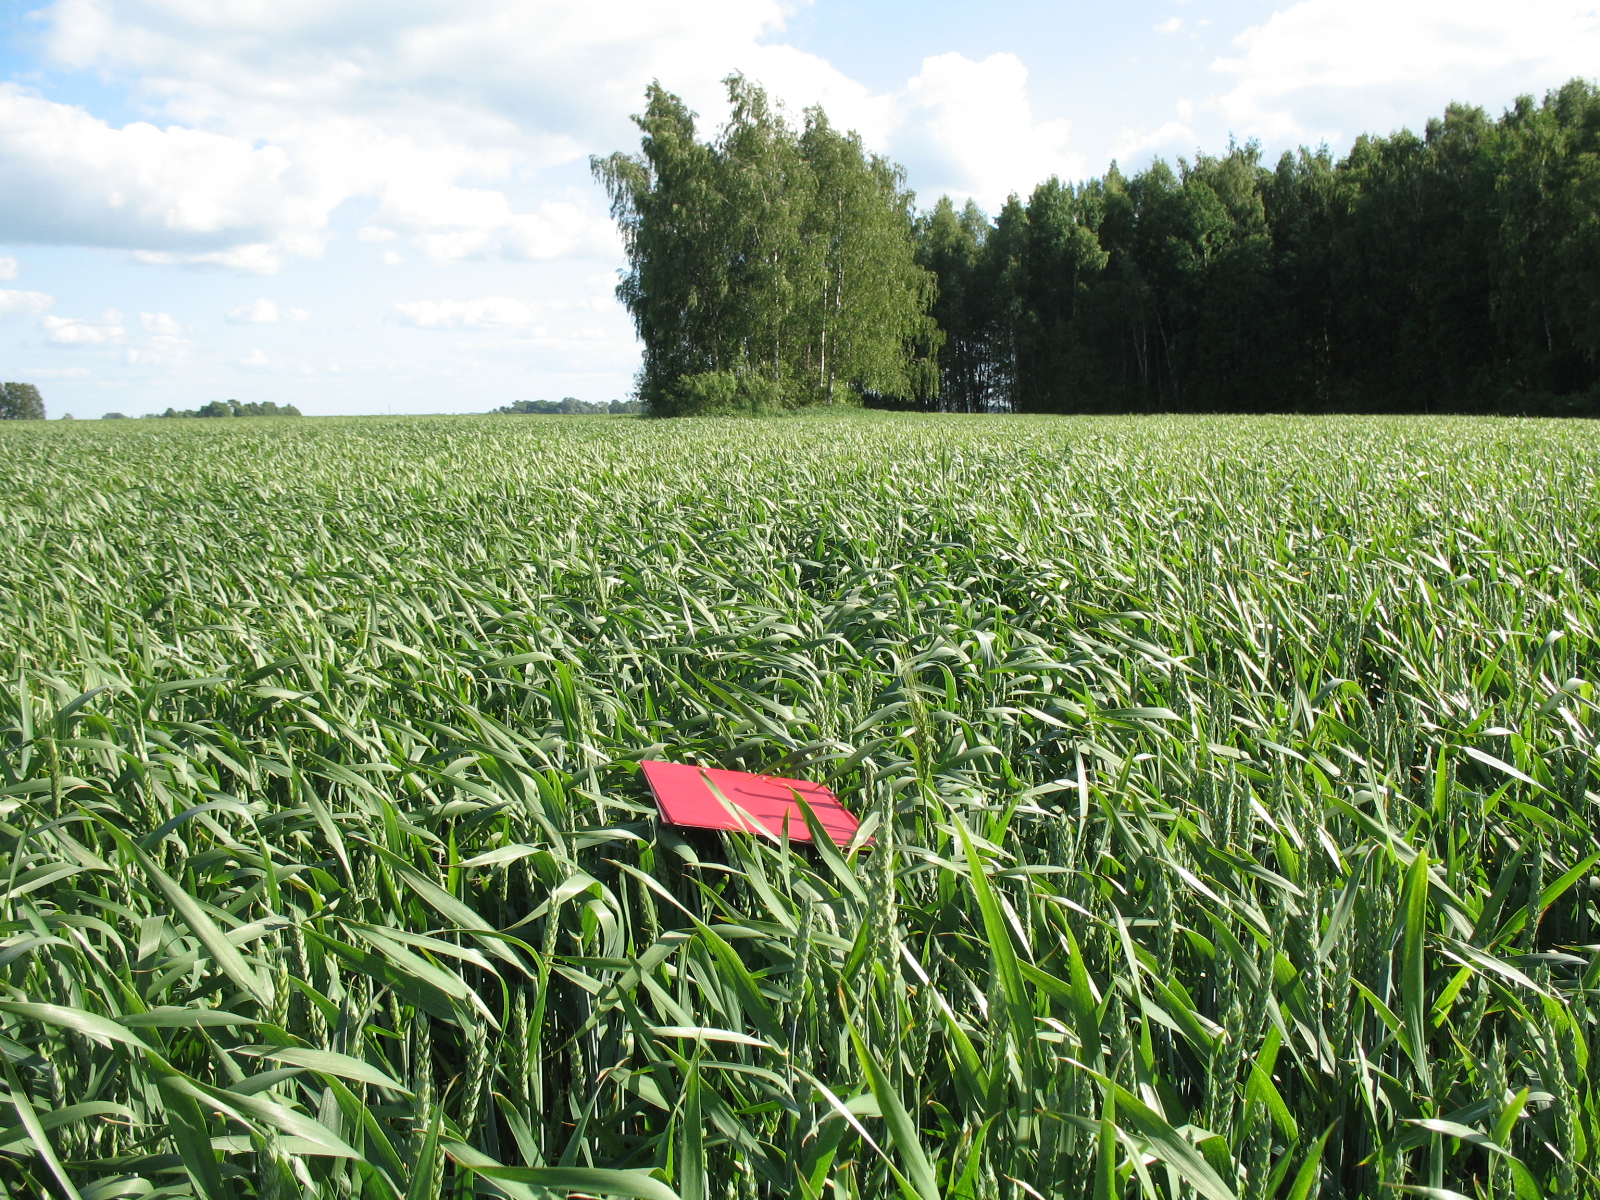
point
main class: Cropland
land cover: Common wheat
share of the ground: > 75 %
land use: Agriculture (excluding fallow land and kitchen gardens)
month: June
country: LV
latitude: 56.4633
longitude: 23.4309
